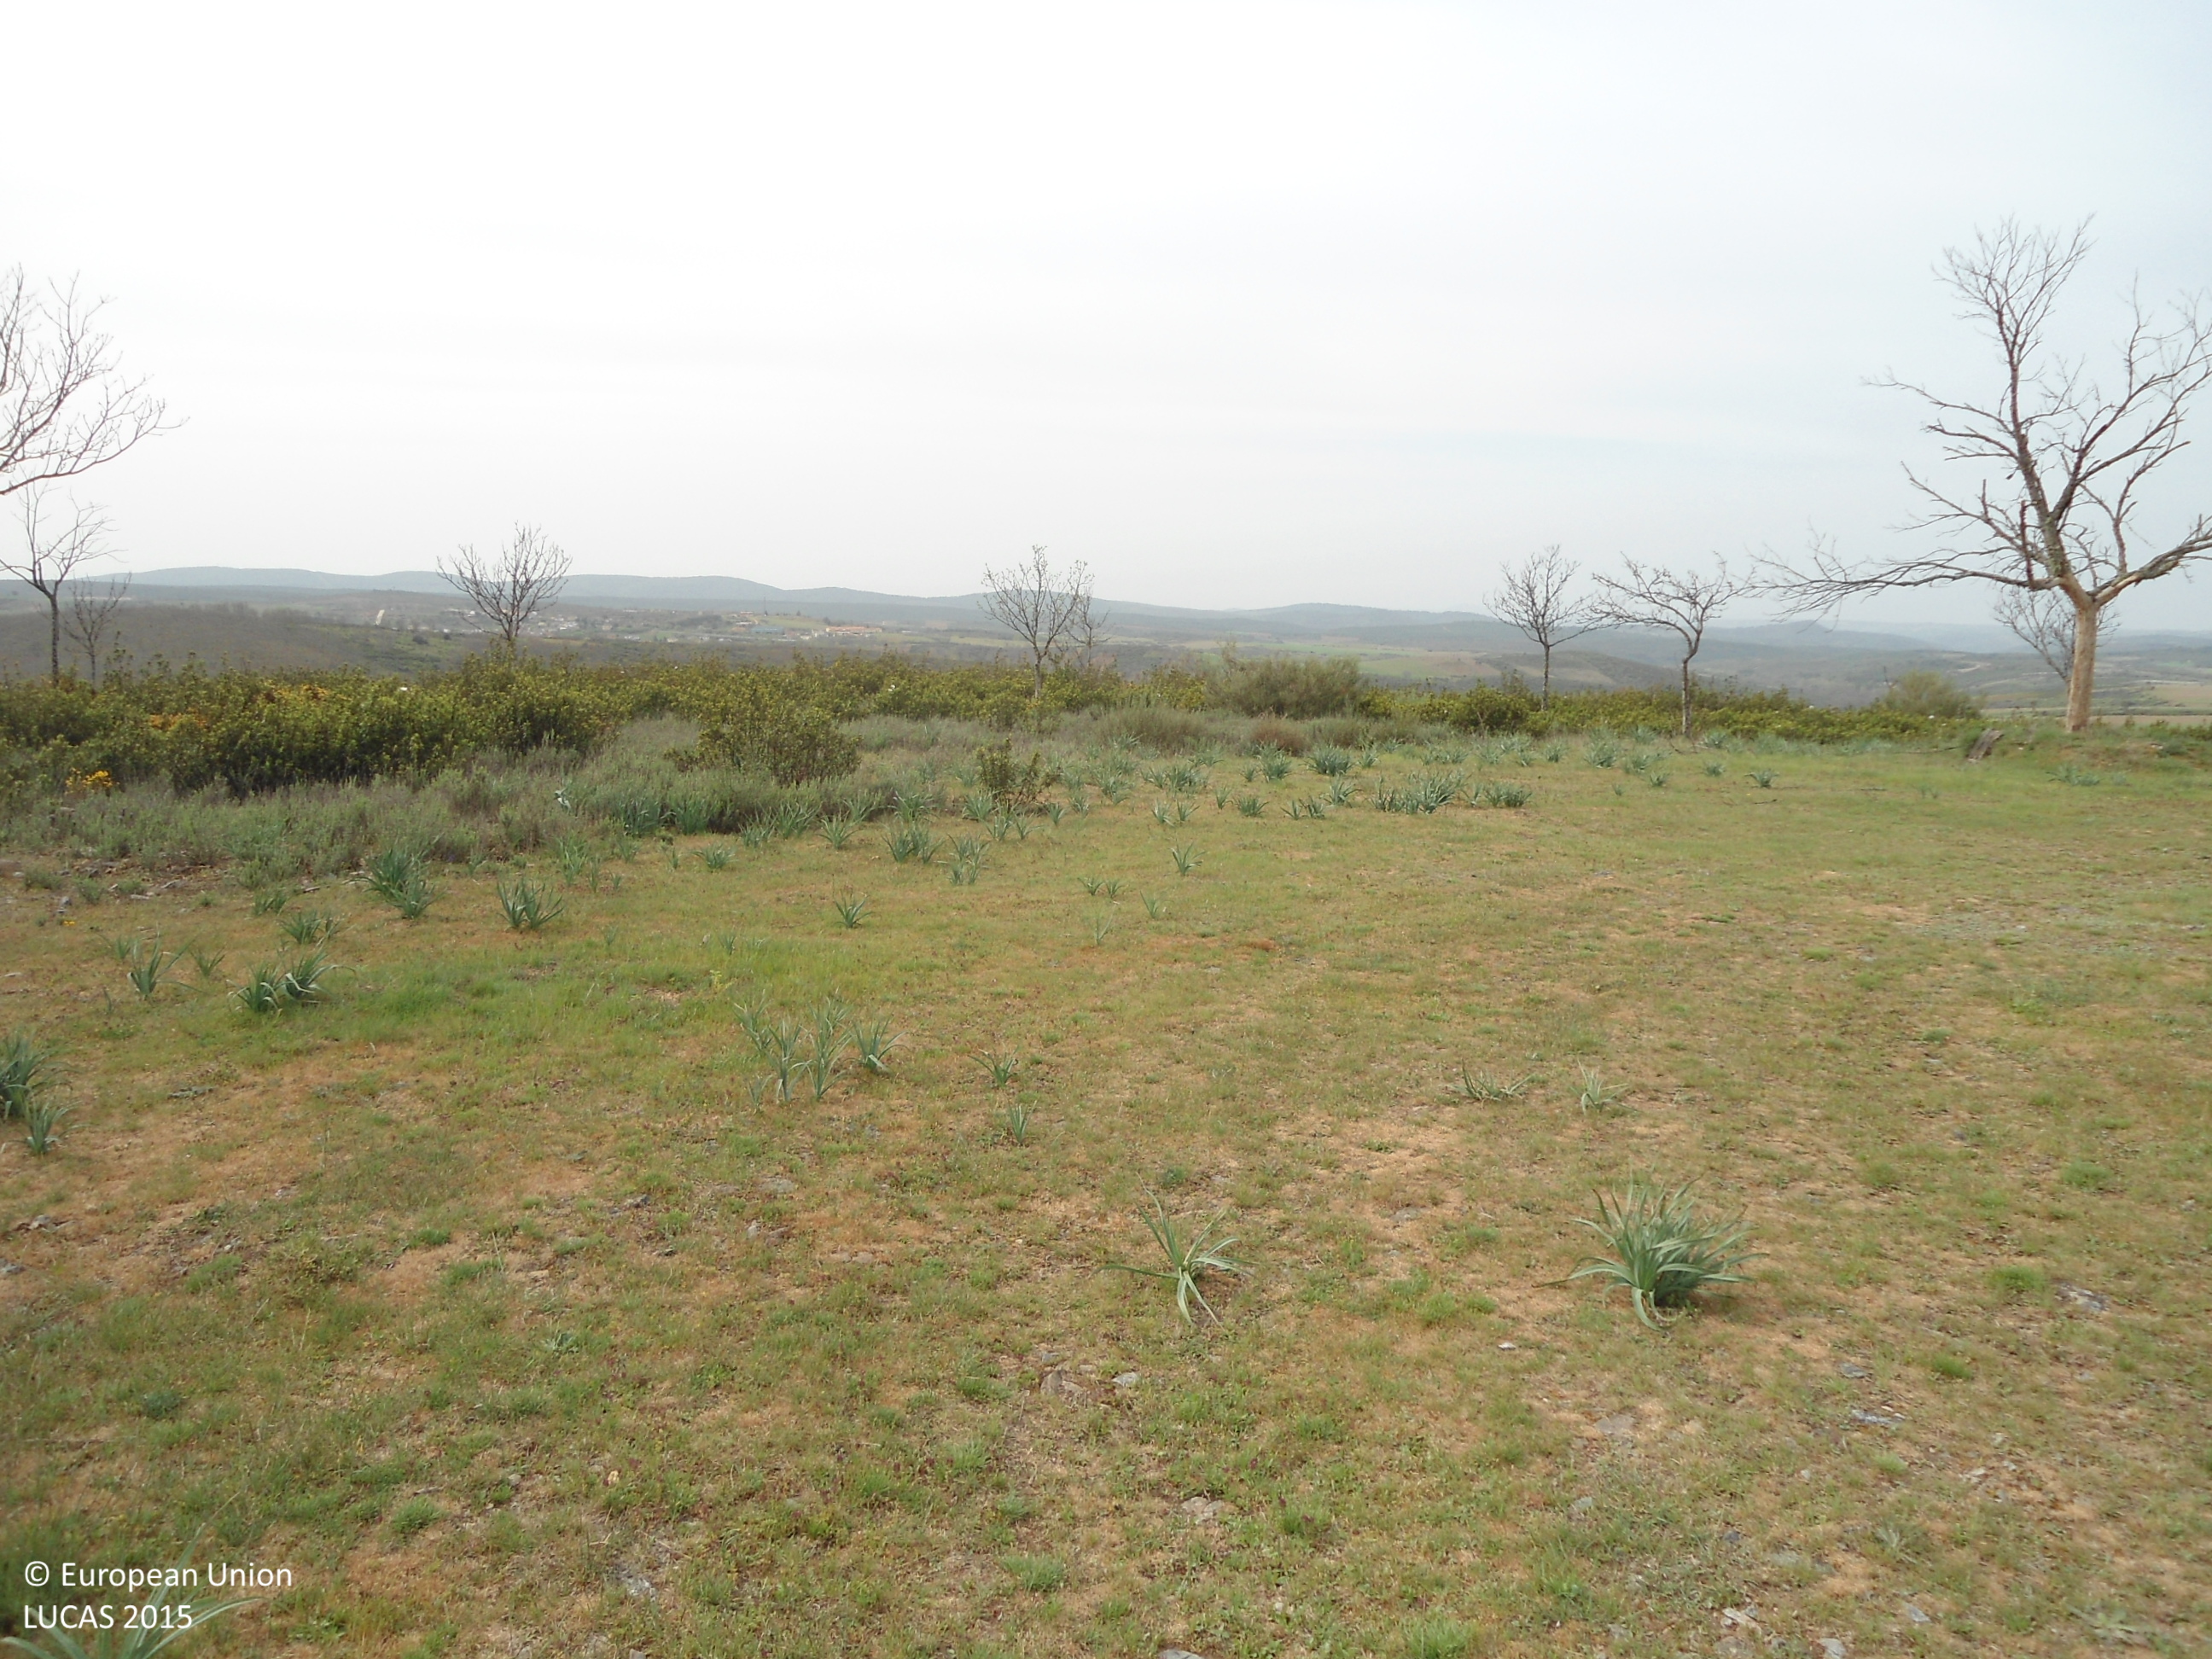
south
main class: Grassland
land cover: Grassland without tree/shrub cover
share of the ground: > 75 %
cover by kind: herbaceous plants 100 %
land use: Community services
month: April
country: ES
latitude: 41.7677
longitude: -6.5024
